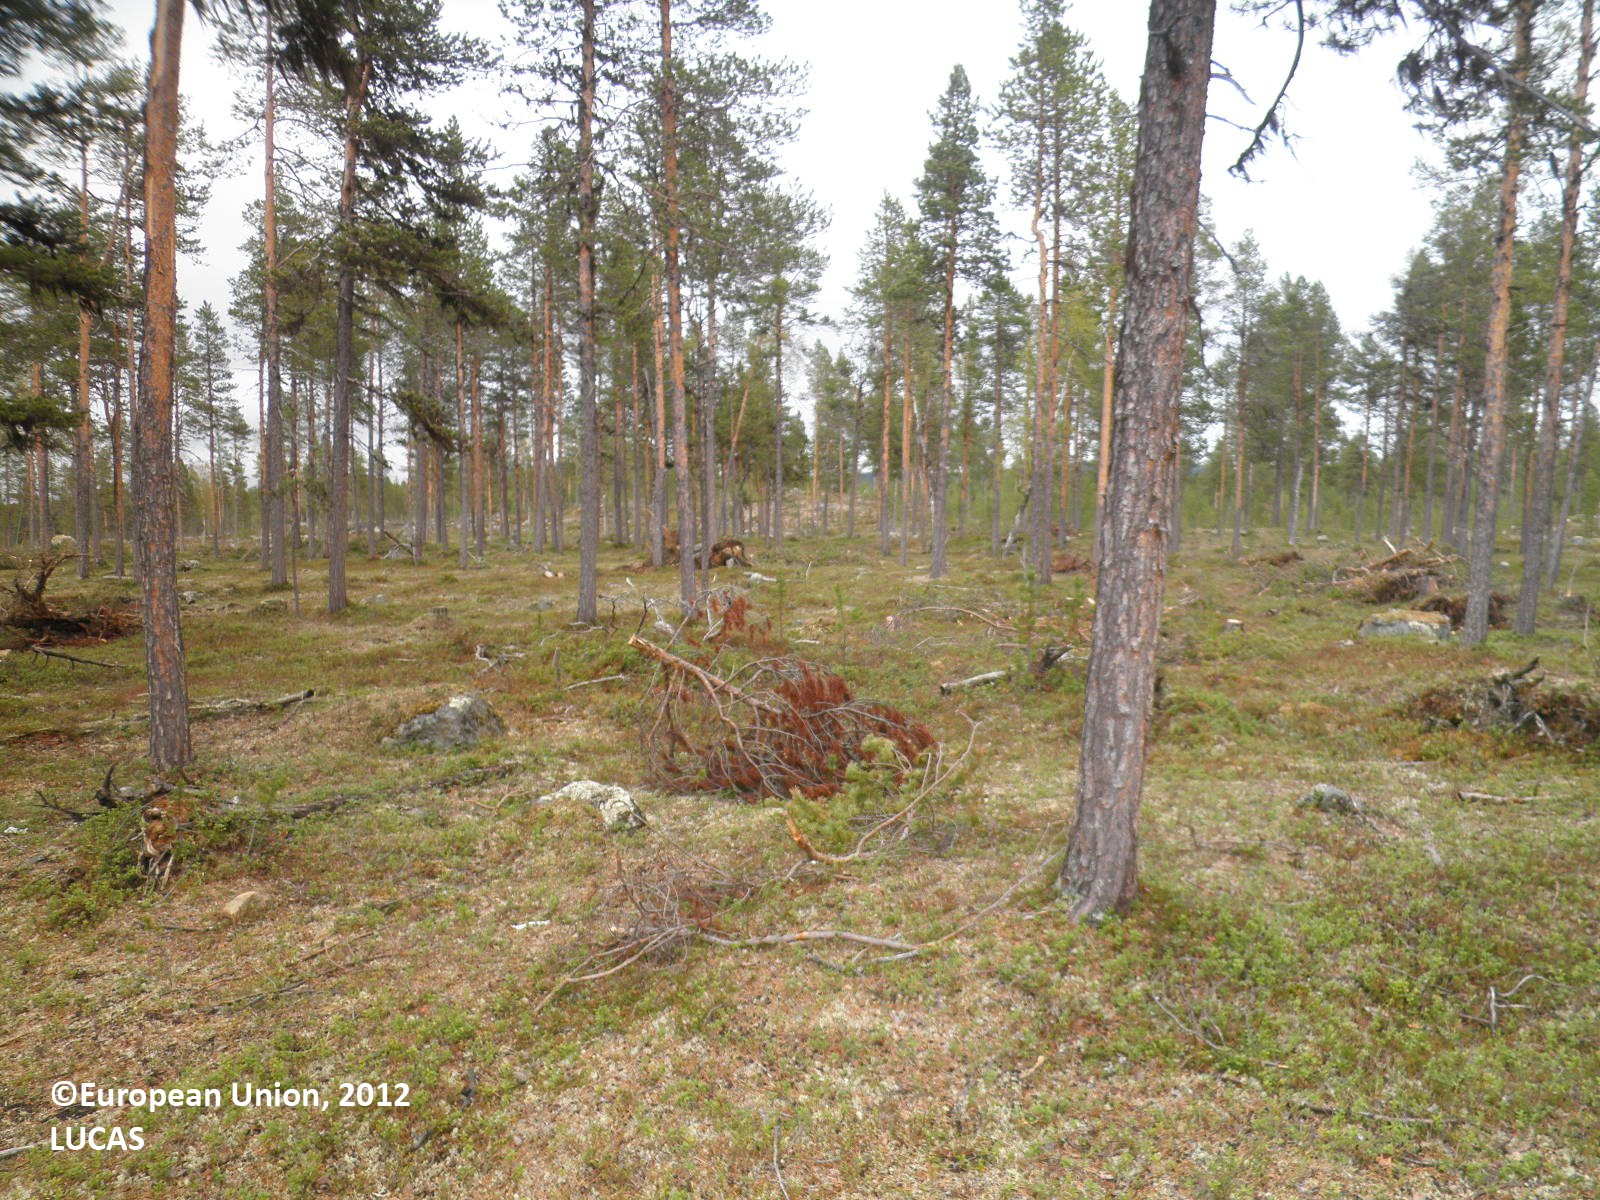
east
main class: Woodland
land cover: Pine dominated coniferous woodland
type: boreal forest
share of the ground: 25 - 50 %
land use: Forestry
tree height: > 5 m
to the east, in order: Pine dominated coniferous woodland
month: June
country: FI
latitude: 68.9237
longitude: 26.4668
